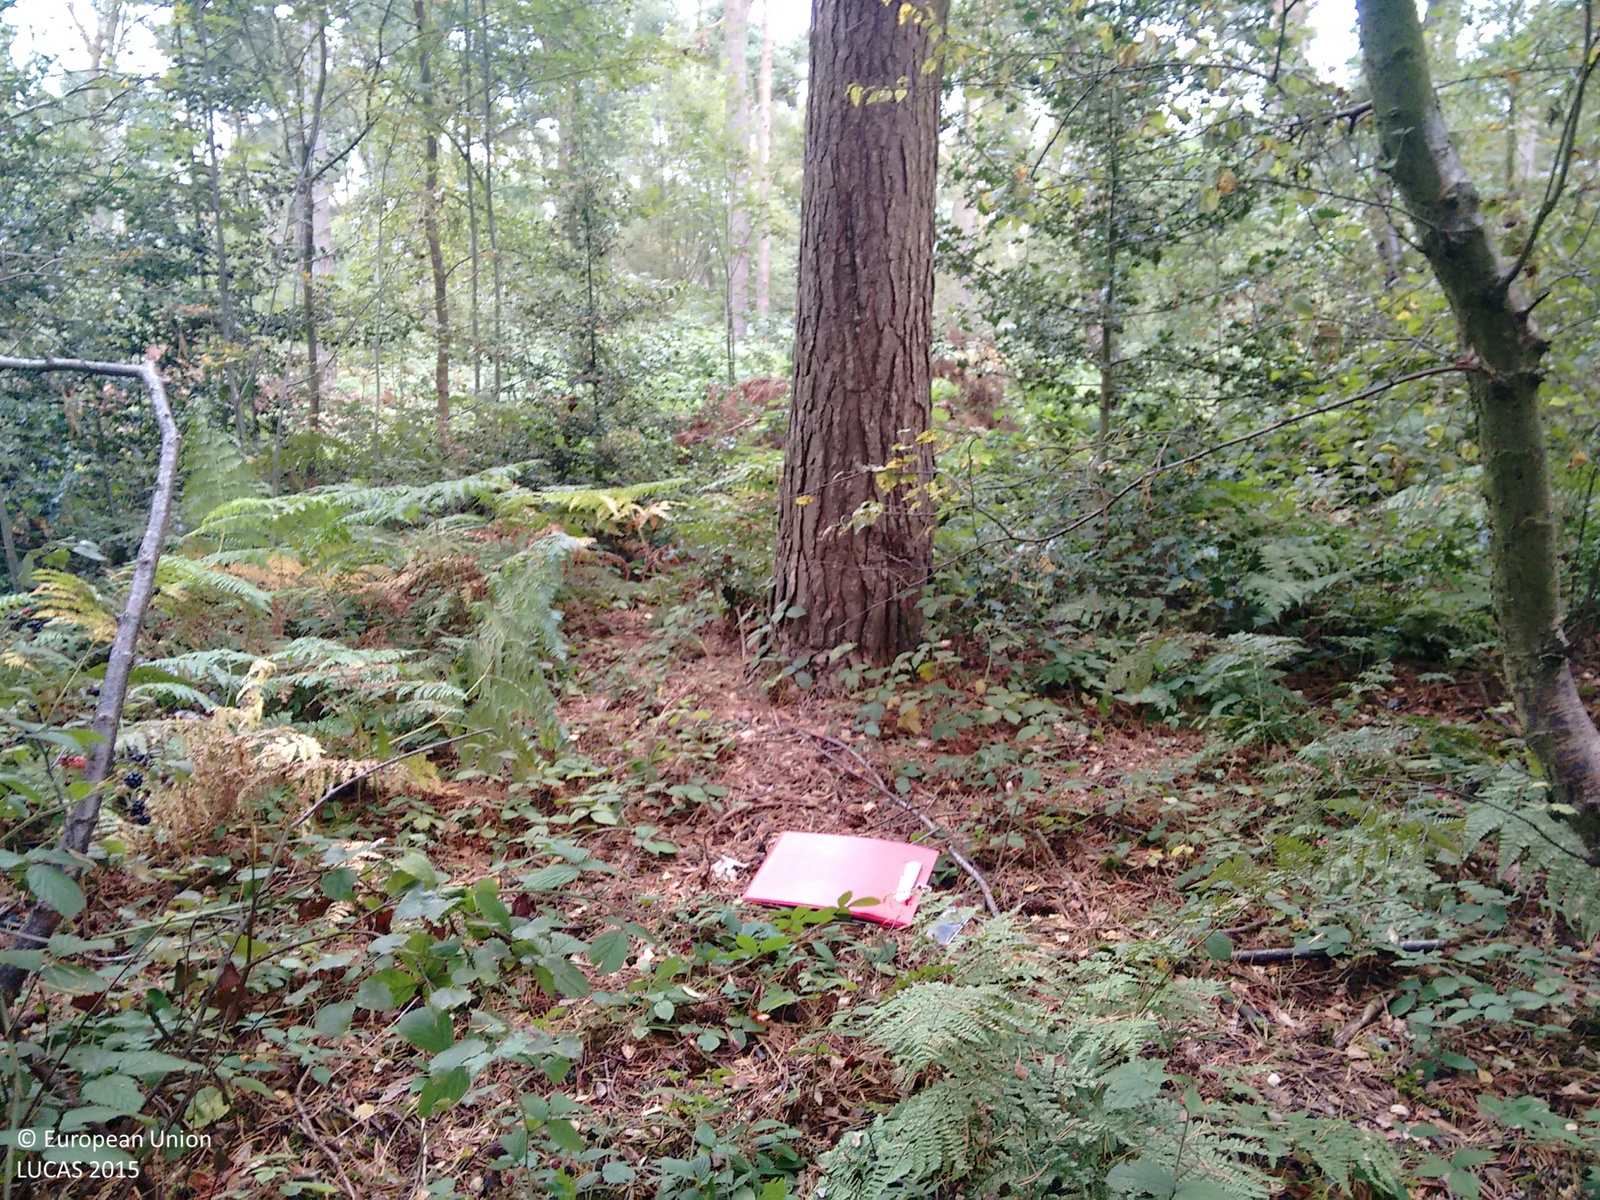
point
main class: Woodland
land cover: Broadleaved woodland
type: mesophytic deciduous forest
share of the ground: > 75 %
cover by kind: broadleaved forest trees 95 %, shrubs 5 %
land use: Amenities, museums, leisure
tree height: > 5 m
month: September
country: GB
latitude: 52.7084
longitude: -2.0326
